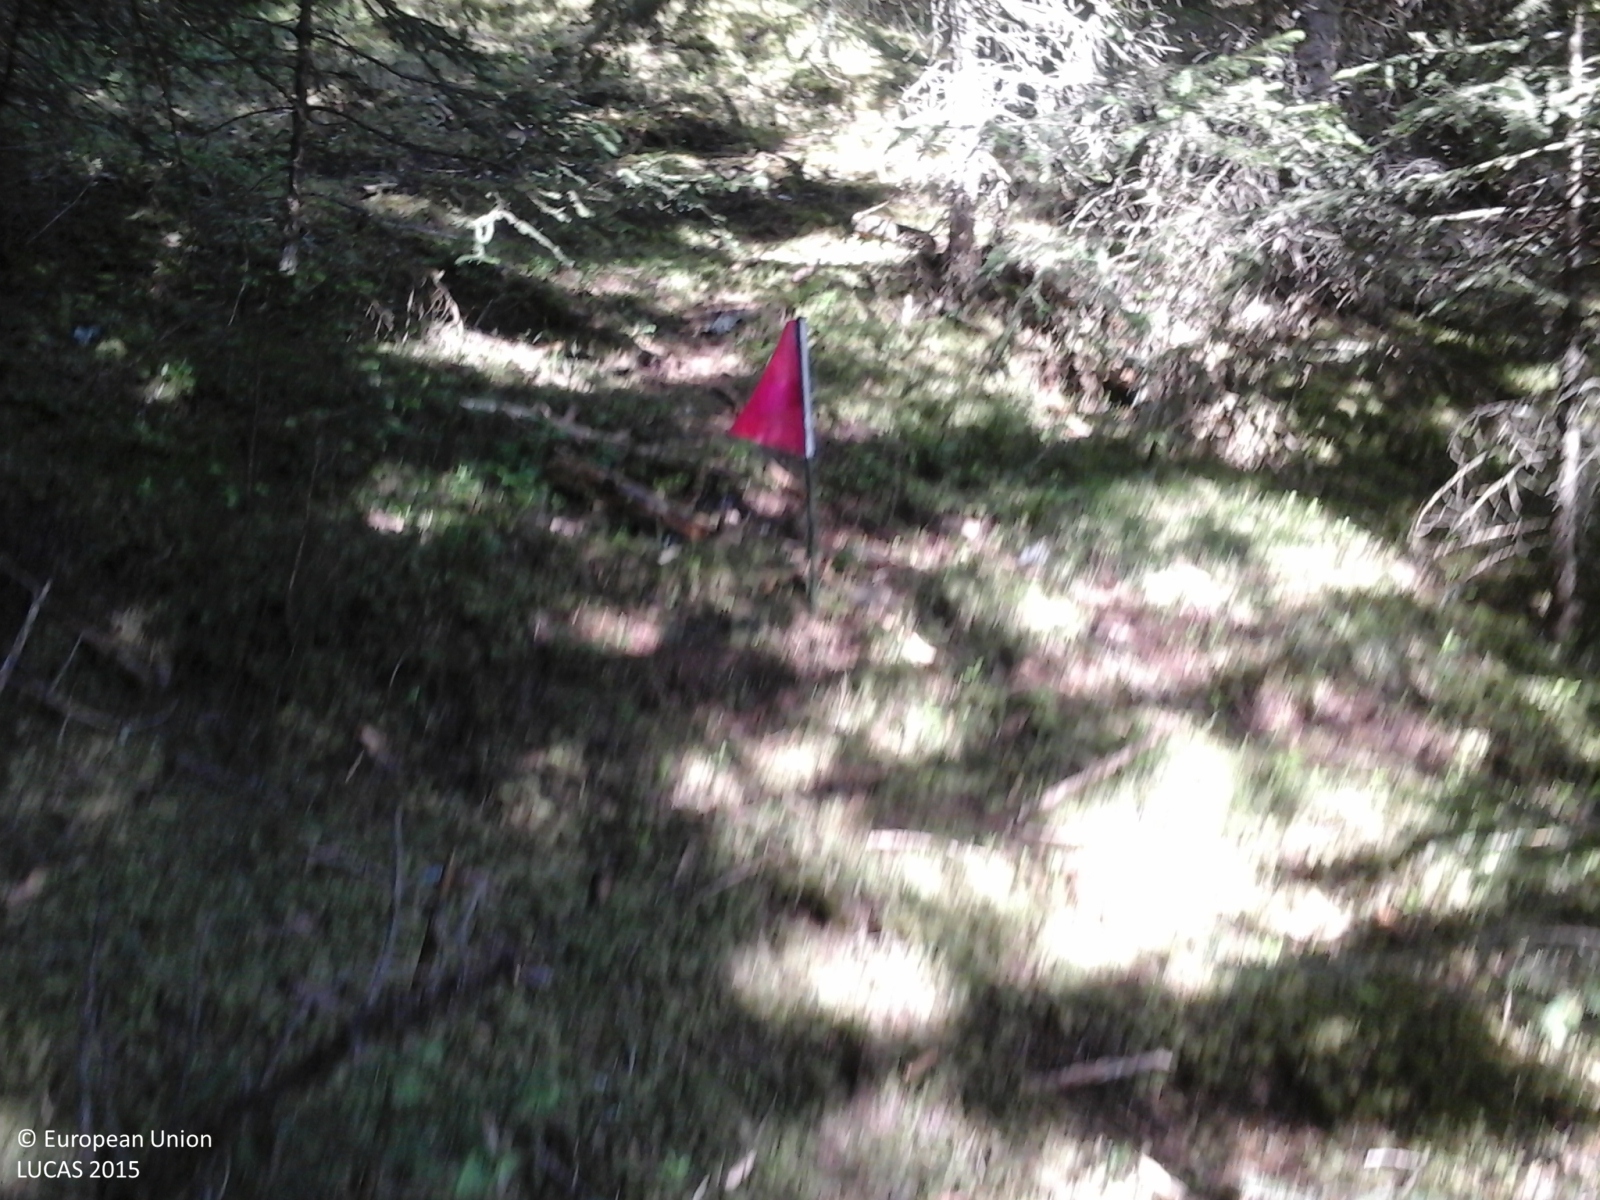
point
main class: Woodland
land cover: Spruce dominated coniferous woodland
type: alpine coniferous forest
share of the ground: > 75 %
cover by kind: coniferous forest trees 100 %
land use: Forestry
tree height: > 5 m
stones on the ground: 25 - 50 %
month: June
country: IT
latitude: 46.6994
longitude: 11.6068
